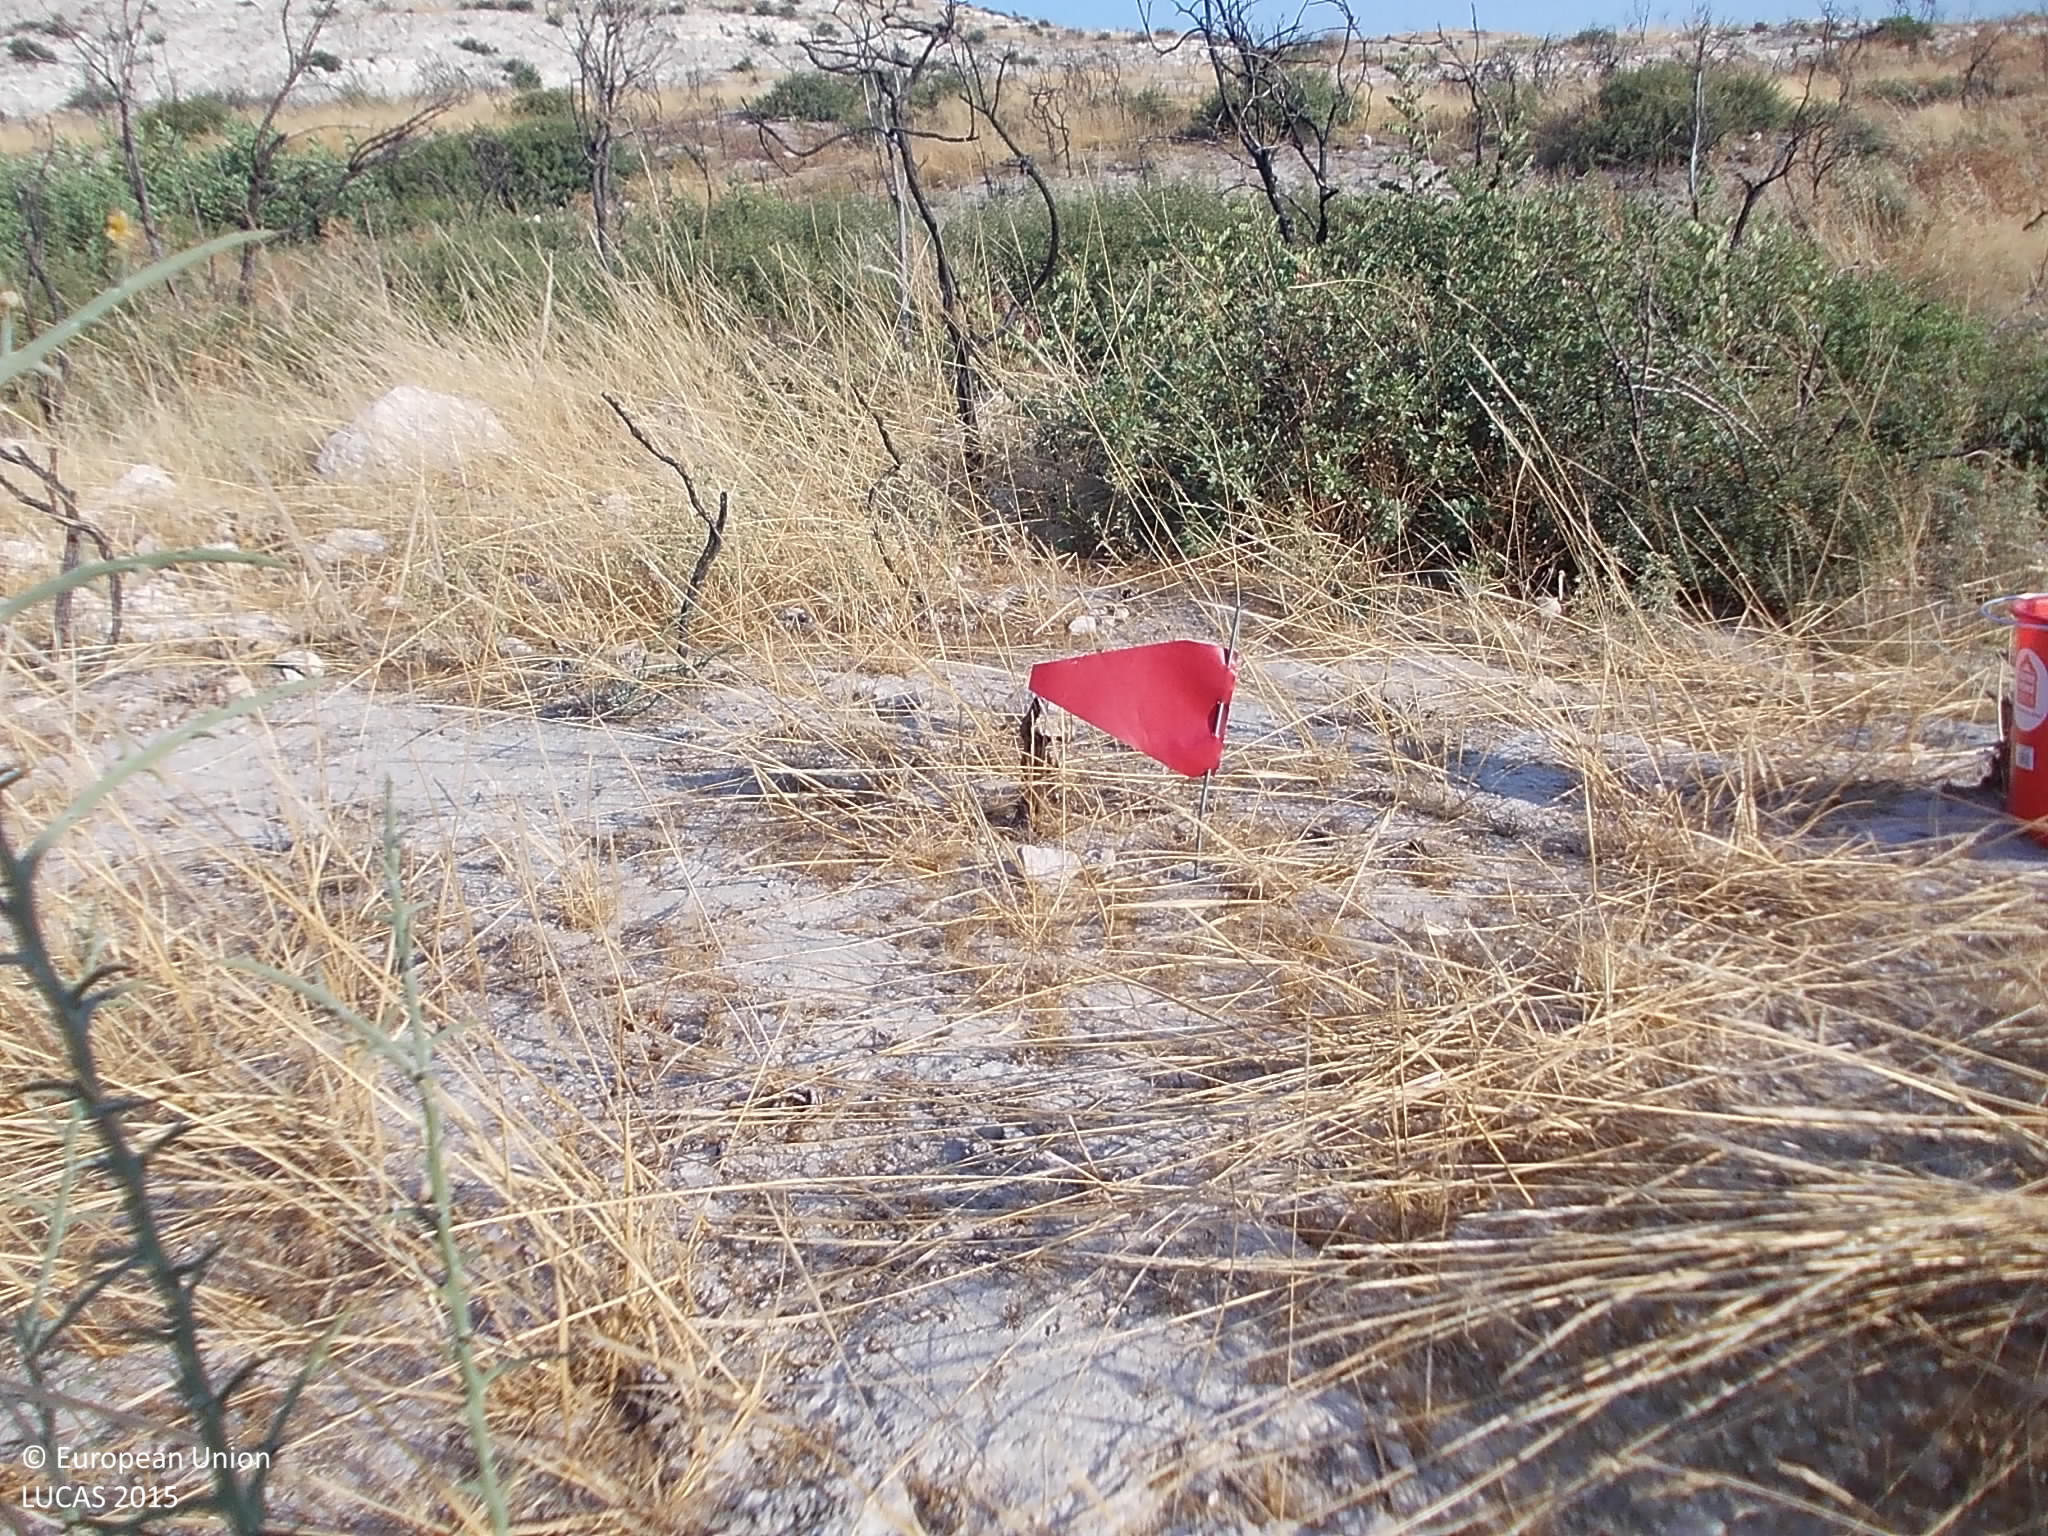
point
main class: Shrubland
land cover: Shrubland without tree cover
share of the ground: 10 - 25 %
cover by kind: unconsolidated bare surface 70 %, herbaceous plants 20 %, shrubs 10 %
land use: Semi-natural and natural areas not in use
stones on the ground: 10 - 25 %
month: August
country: CY
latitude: 34.6944
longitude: 32.8757
